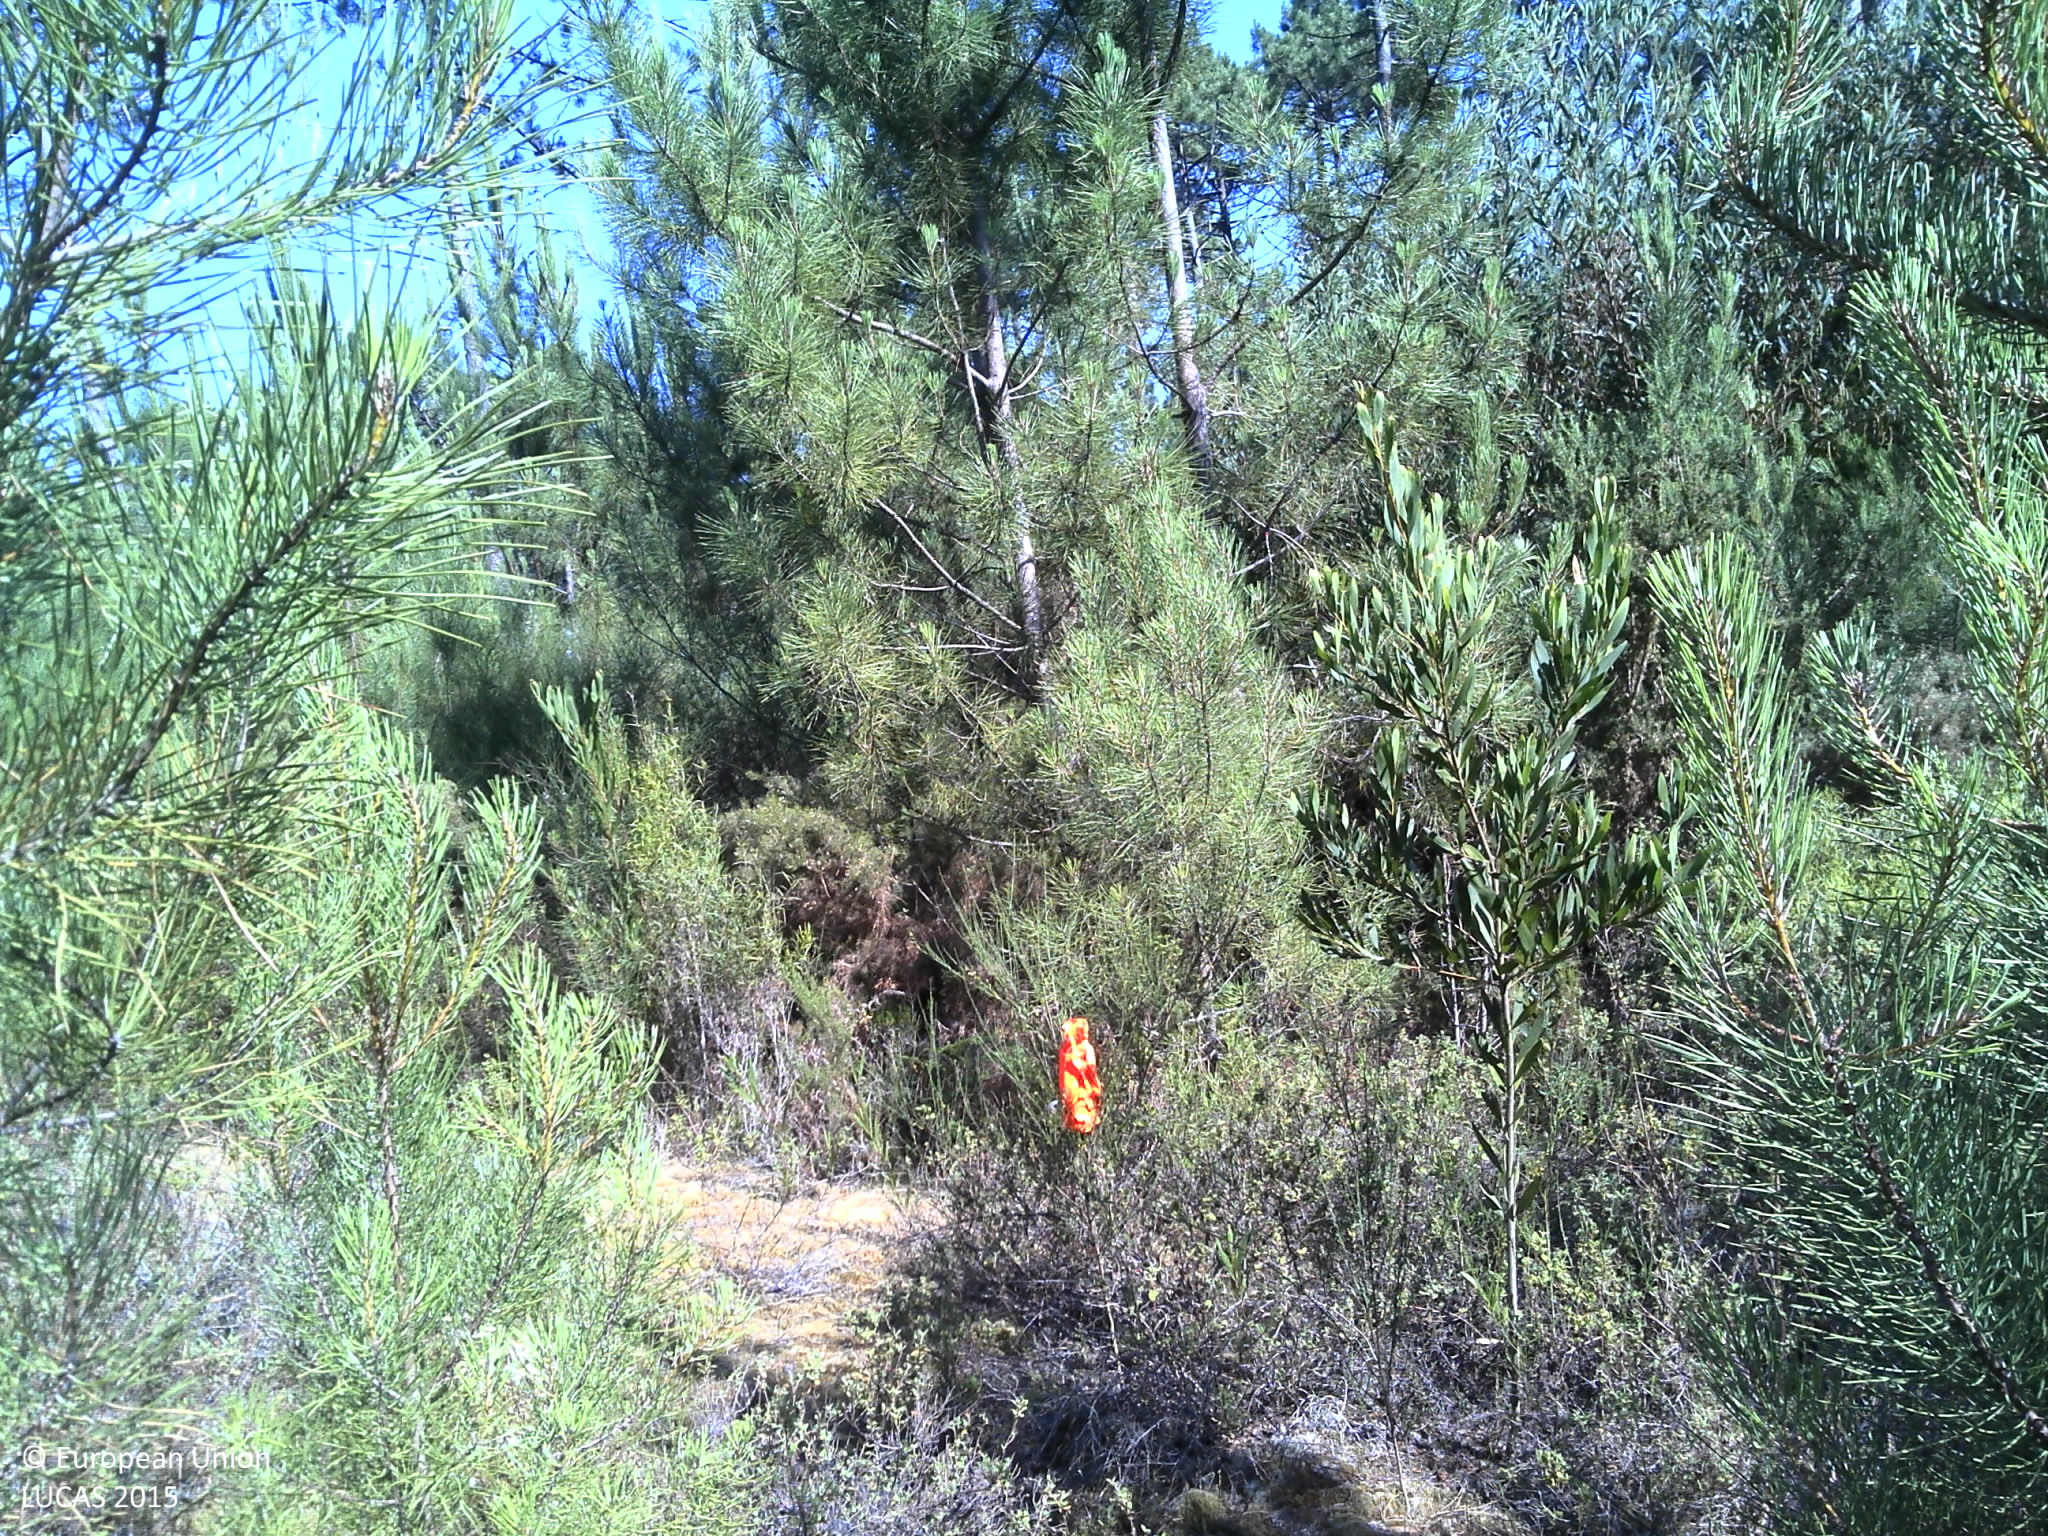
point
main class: Woodland
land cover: Pine dominated coniferous woodland
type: coniferous forest of the mediterranean region
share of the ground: 50 - 75 %
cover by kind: coniferous forest trees 60 %, shrubs 30 %, unconsolidated bare surface 10 %
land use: Forestry
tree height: > 5 m
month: June
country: PT
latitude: 39.8647
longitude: -8.9486
